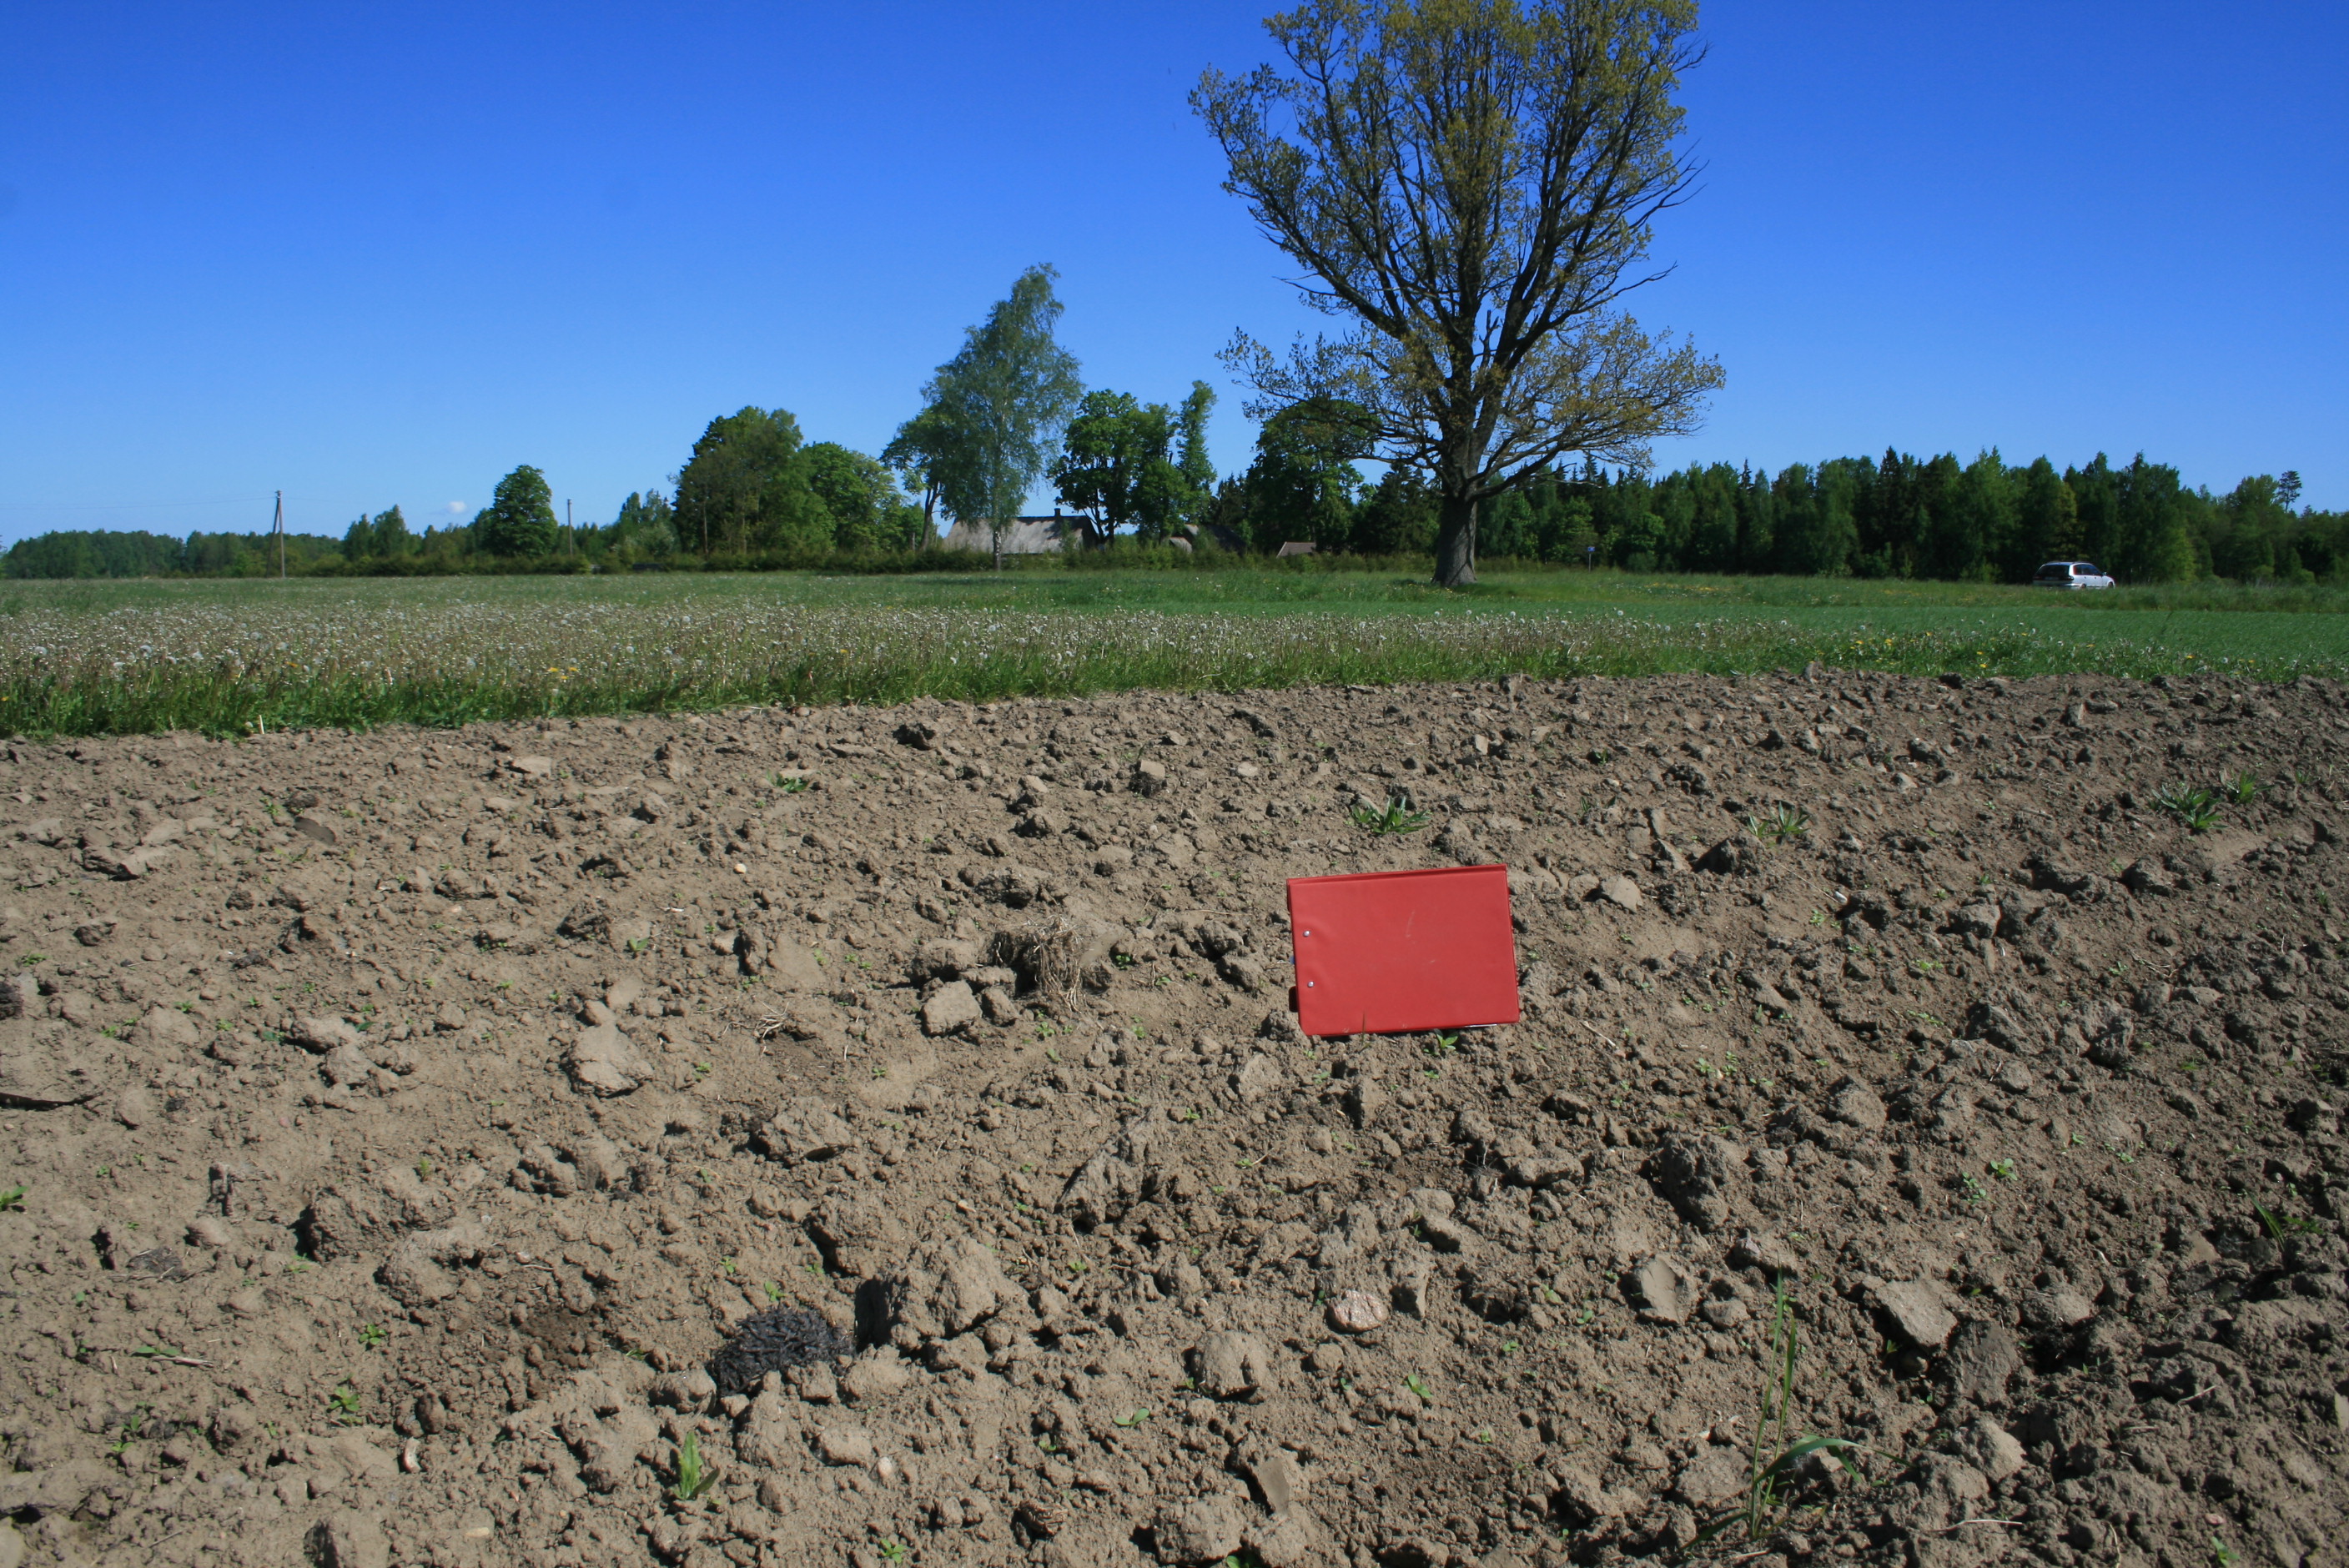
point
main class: Cropland
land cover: Potatoes
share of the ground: < 10 %
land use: Agriculture (excluding fallow land and kitchen gardens)
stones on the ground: < 10 %
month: May
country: LT
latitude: 56.2131
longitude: 22.2929
